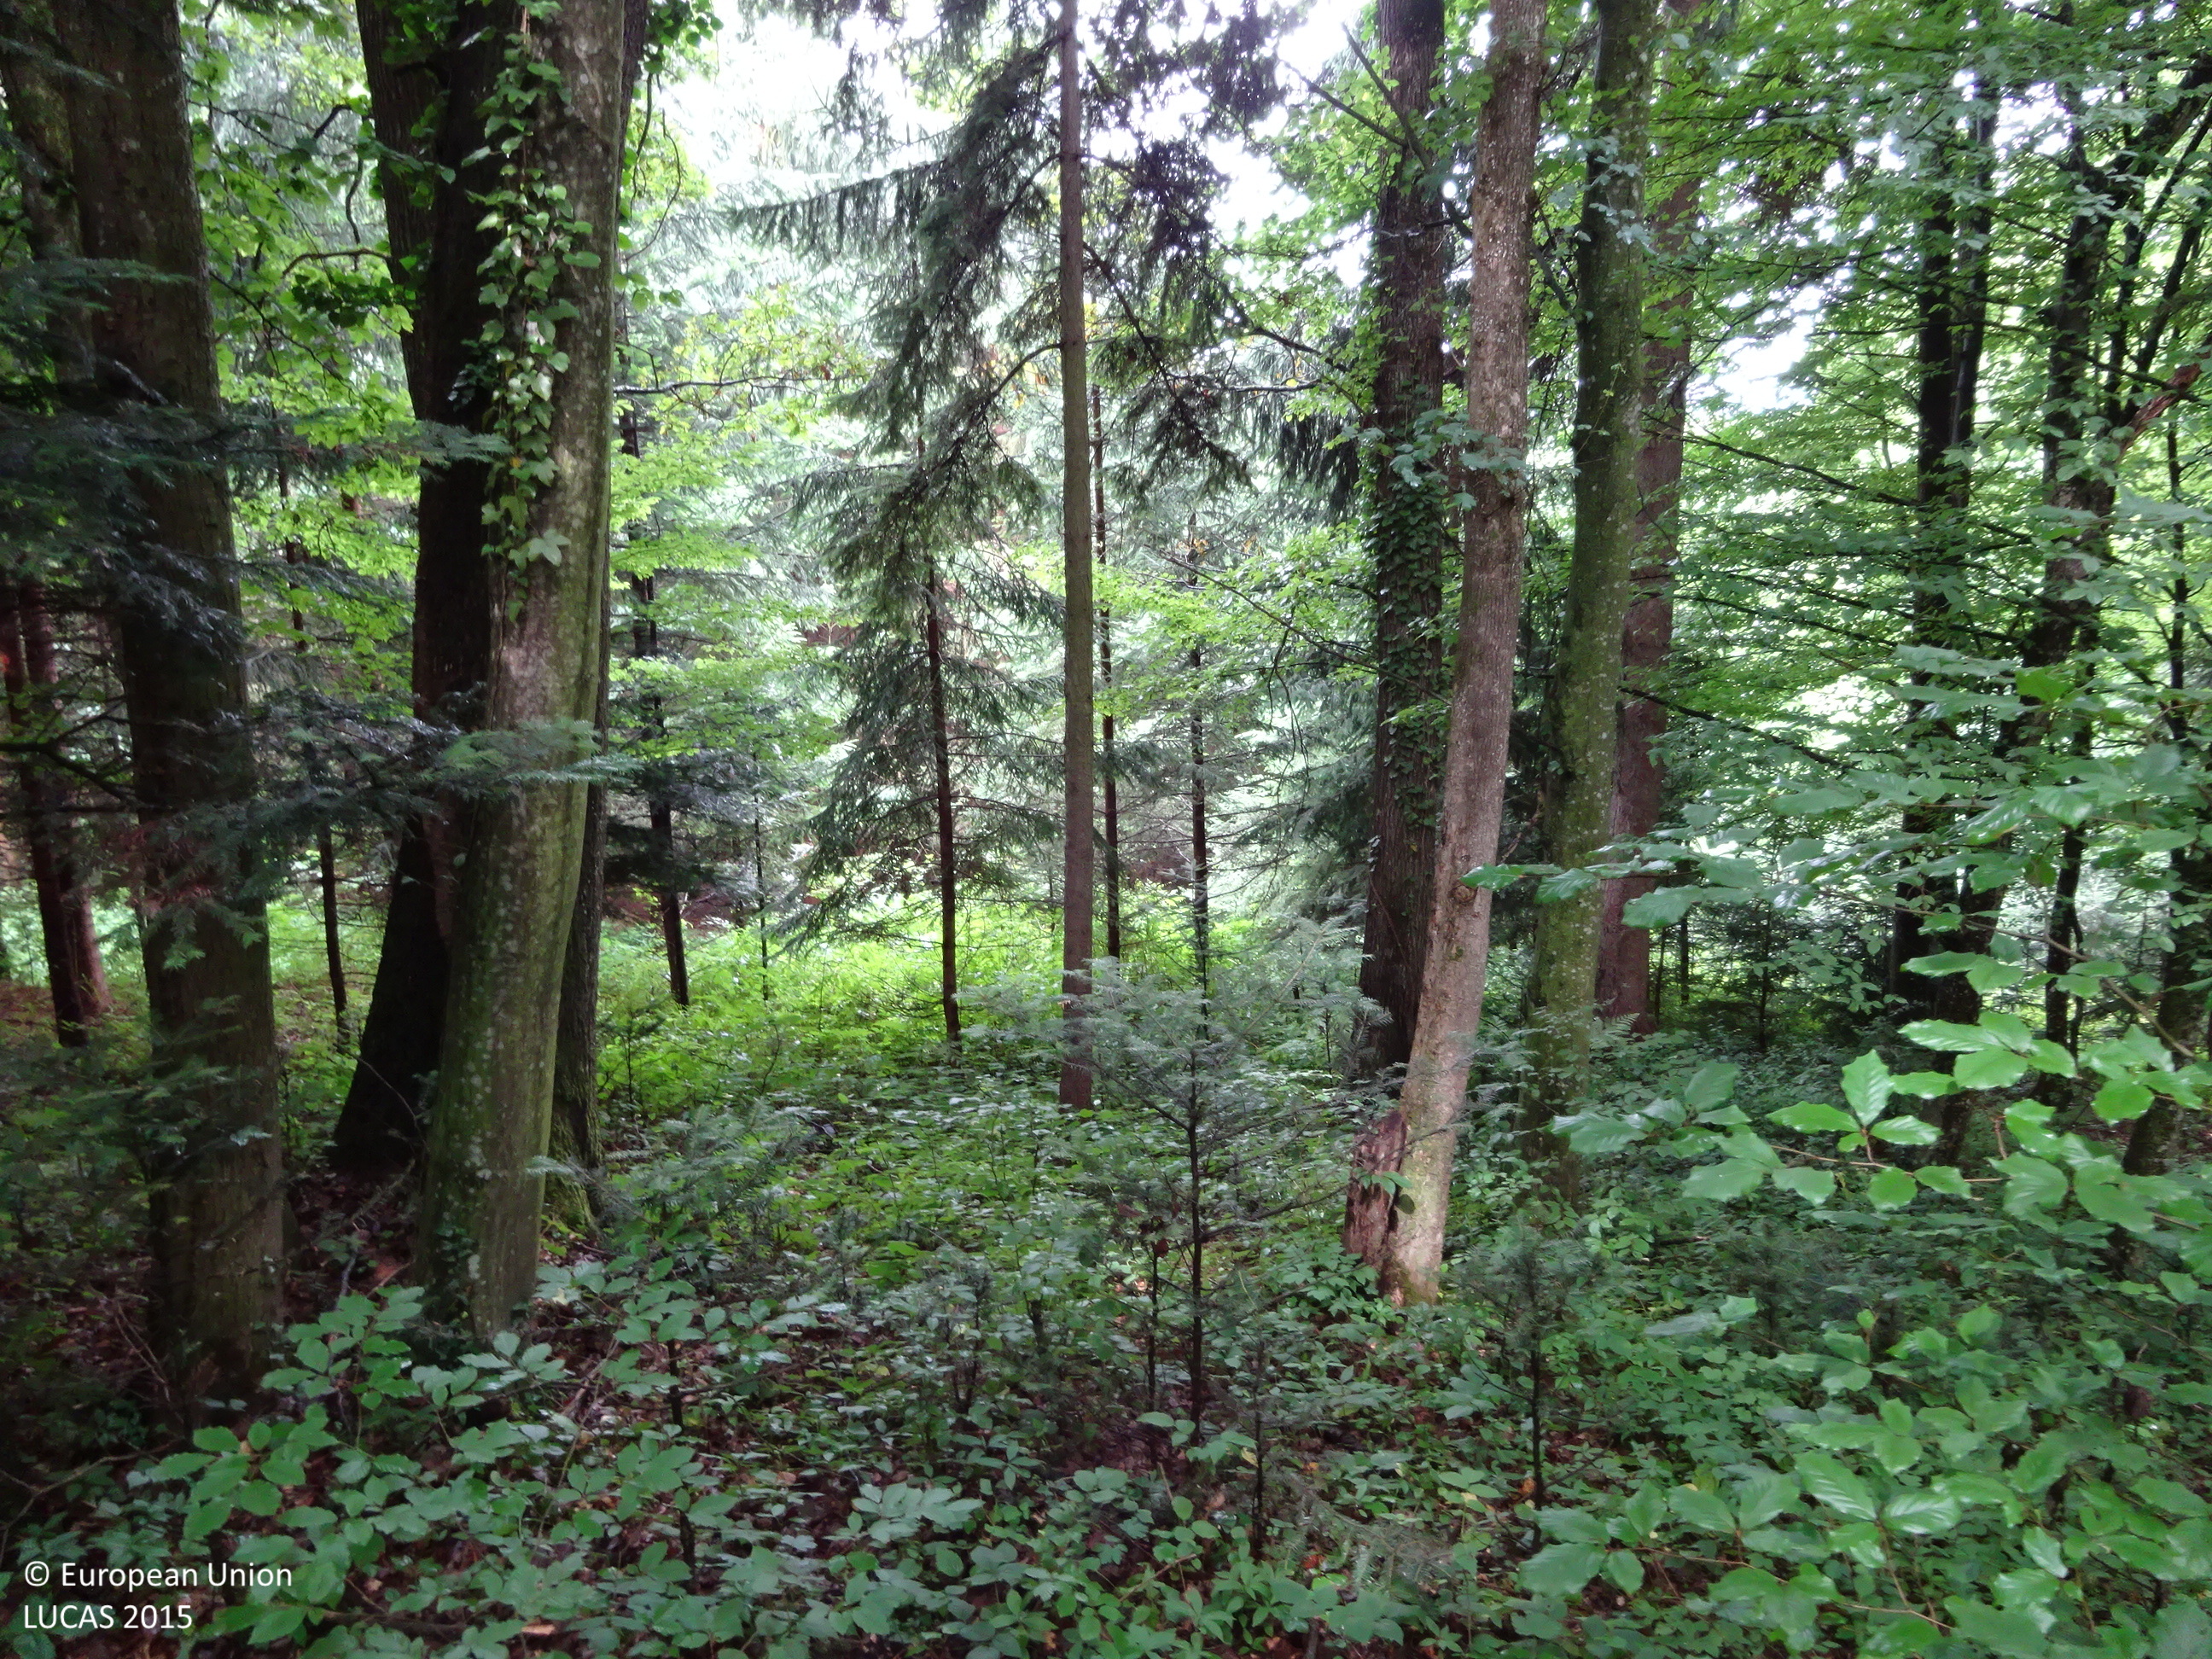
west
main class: Woodland
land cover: Broadleaved woodland
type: mountainous beech forest
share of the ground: > 75 %
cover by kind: broadleaved forest trees 80 %, coniferous forest trees 10 %, herbaceous plants 10 %
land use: Forestry
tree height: > 5 m
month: June
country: AT
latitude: 46.6662
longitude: 15.3968
